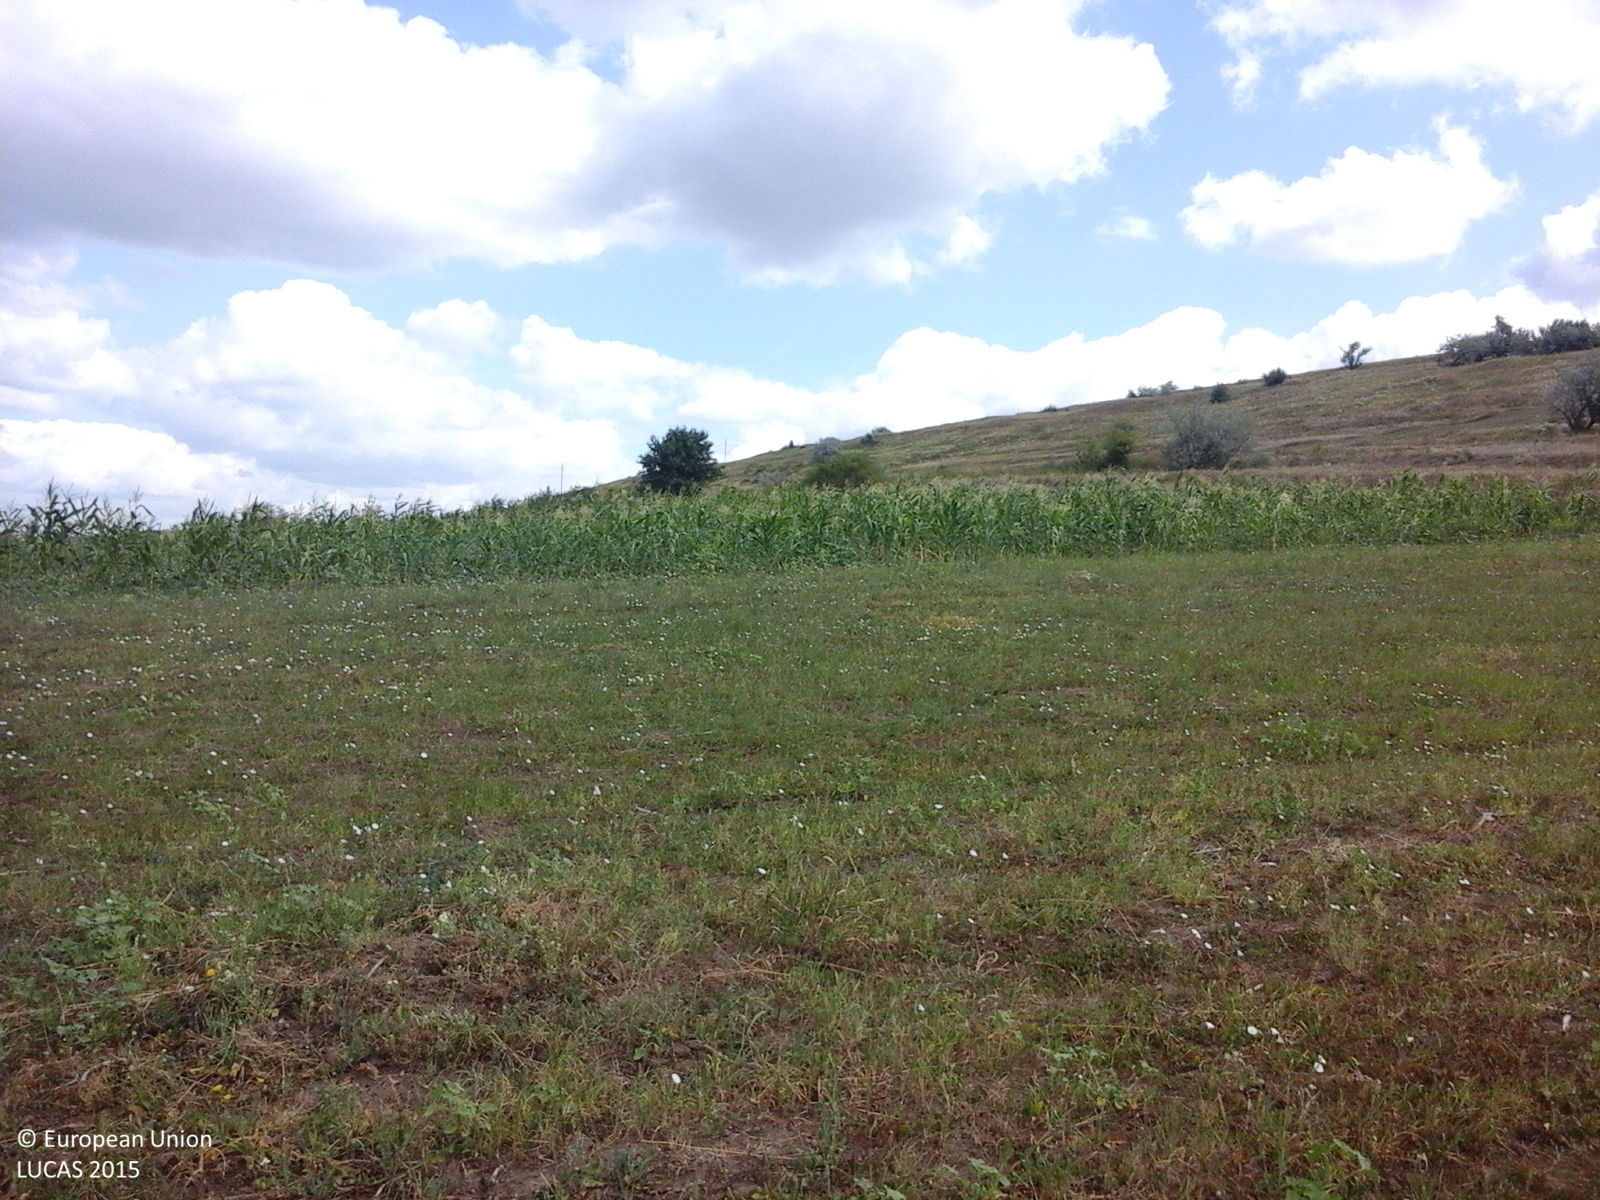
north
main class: Grassland
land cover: Grassland without tree/shrub cover
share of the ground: 10 - 25 %
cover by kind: herbaceous plants 100 %
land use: Agriculture (excluding fallow land and kitchen gardens)
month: July
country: RO
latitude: 46.4156
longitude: 27.3170
